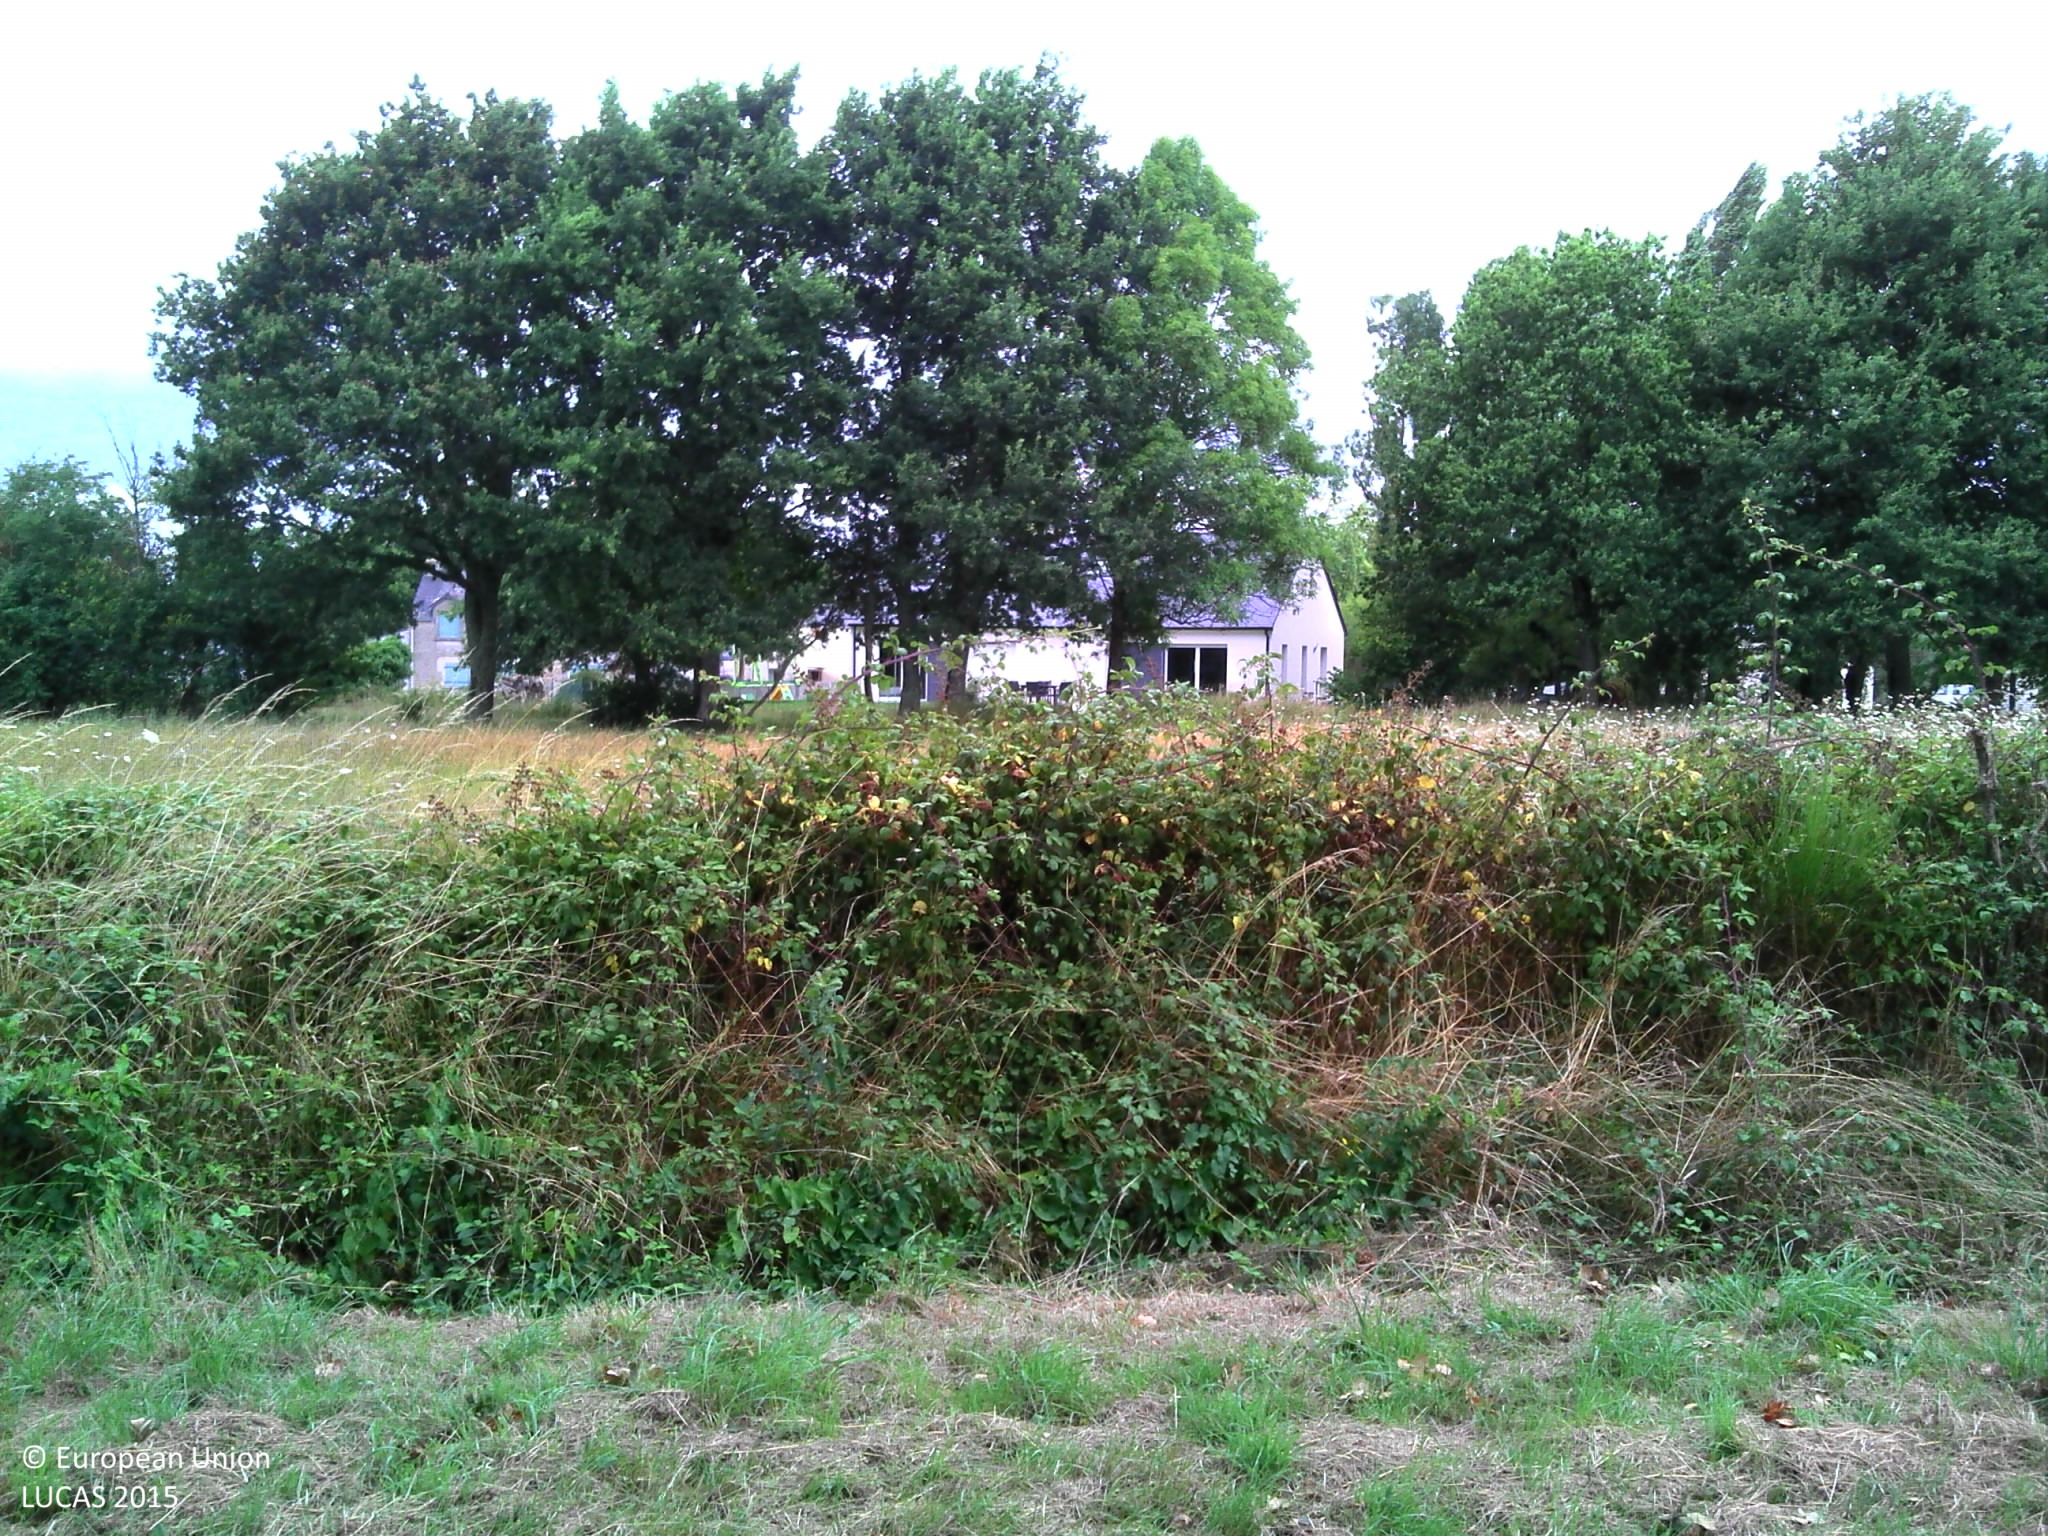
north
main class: Grassland
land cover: Grassland without tree/shrub cover
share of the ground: > 75 %
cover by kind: herbaceous plants 100 %
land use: Road transport
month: July
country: FR
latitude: 47.4351
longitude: -1.8610
